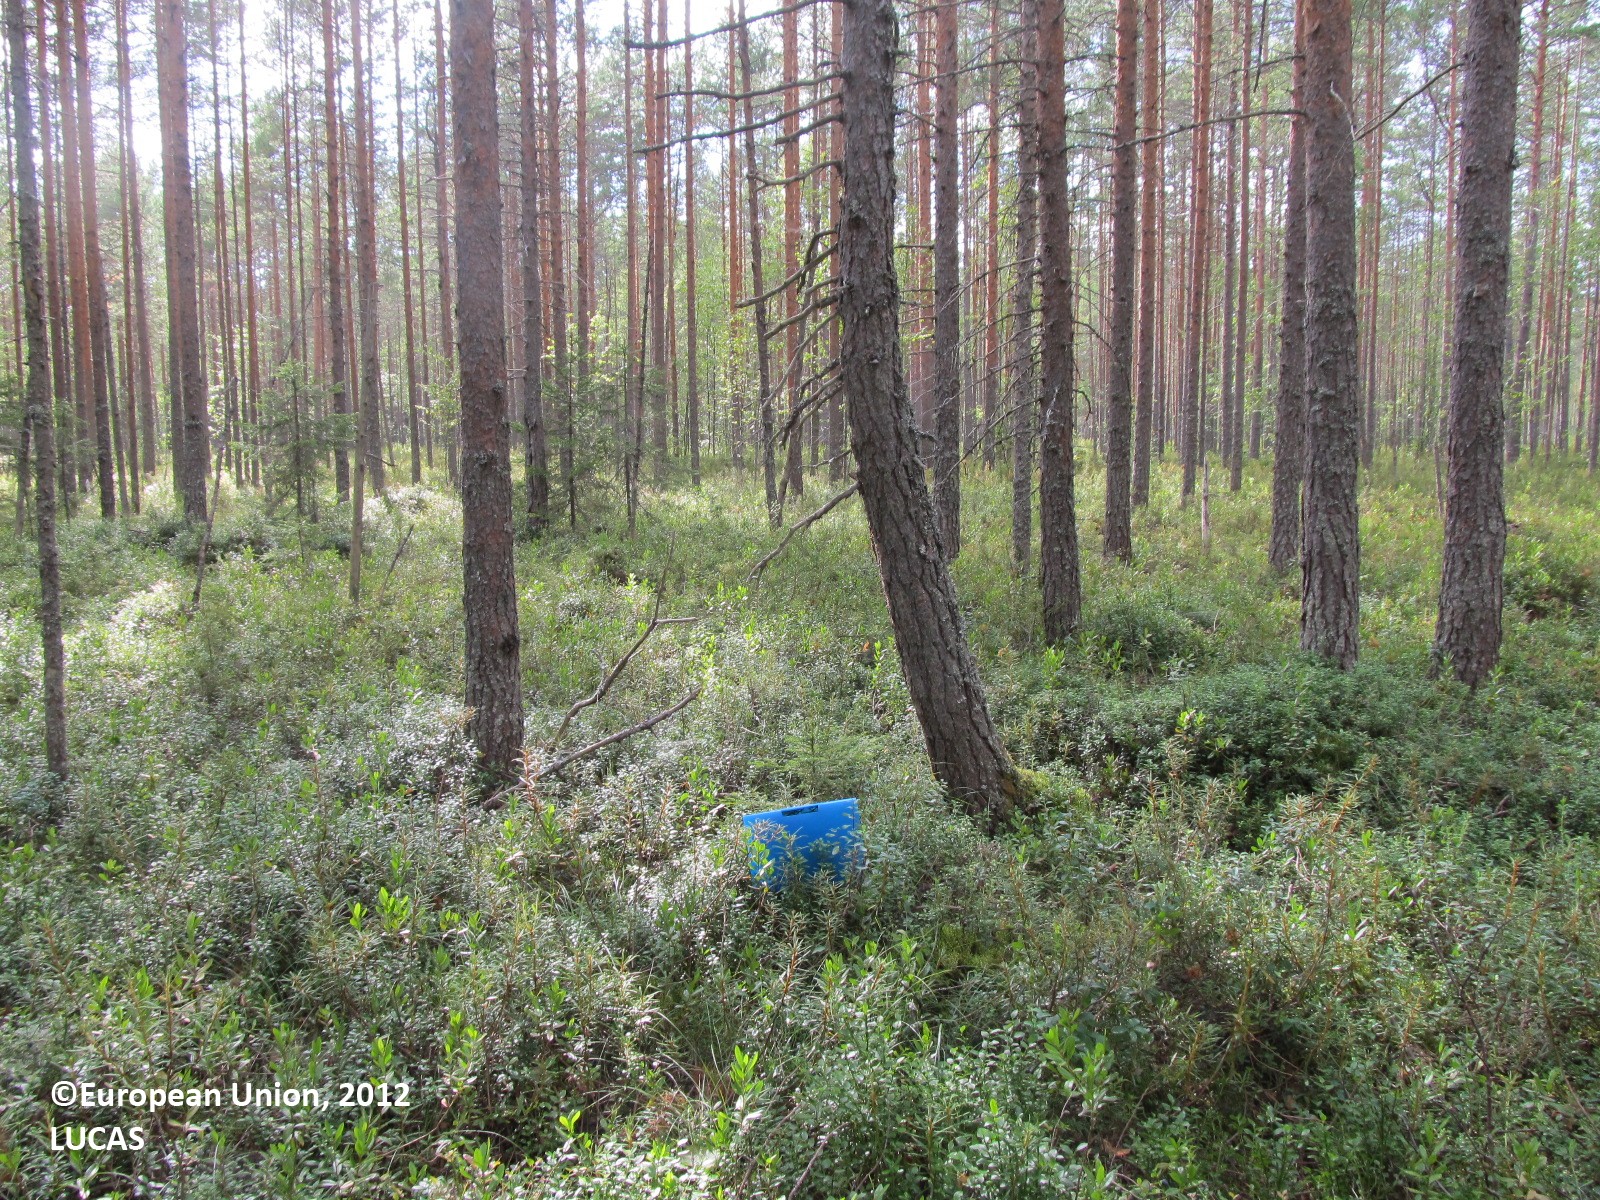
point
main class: Woodland
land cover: Pine dominated coniferous woodland
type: boreal forest
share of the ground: 25 - 50 %
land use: Forestry
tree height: > 5 m
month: August
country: FI
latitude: 62.2922
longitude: 28.4589
